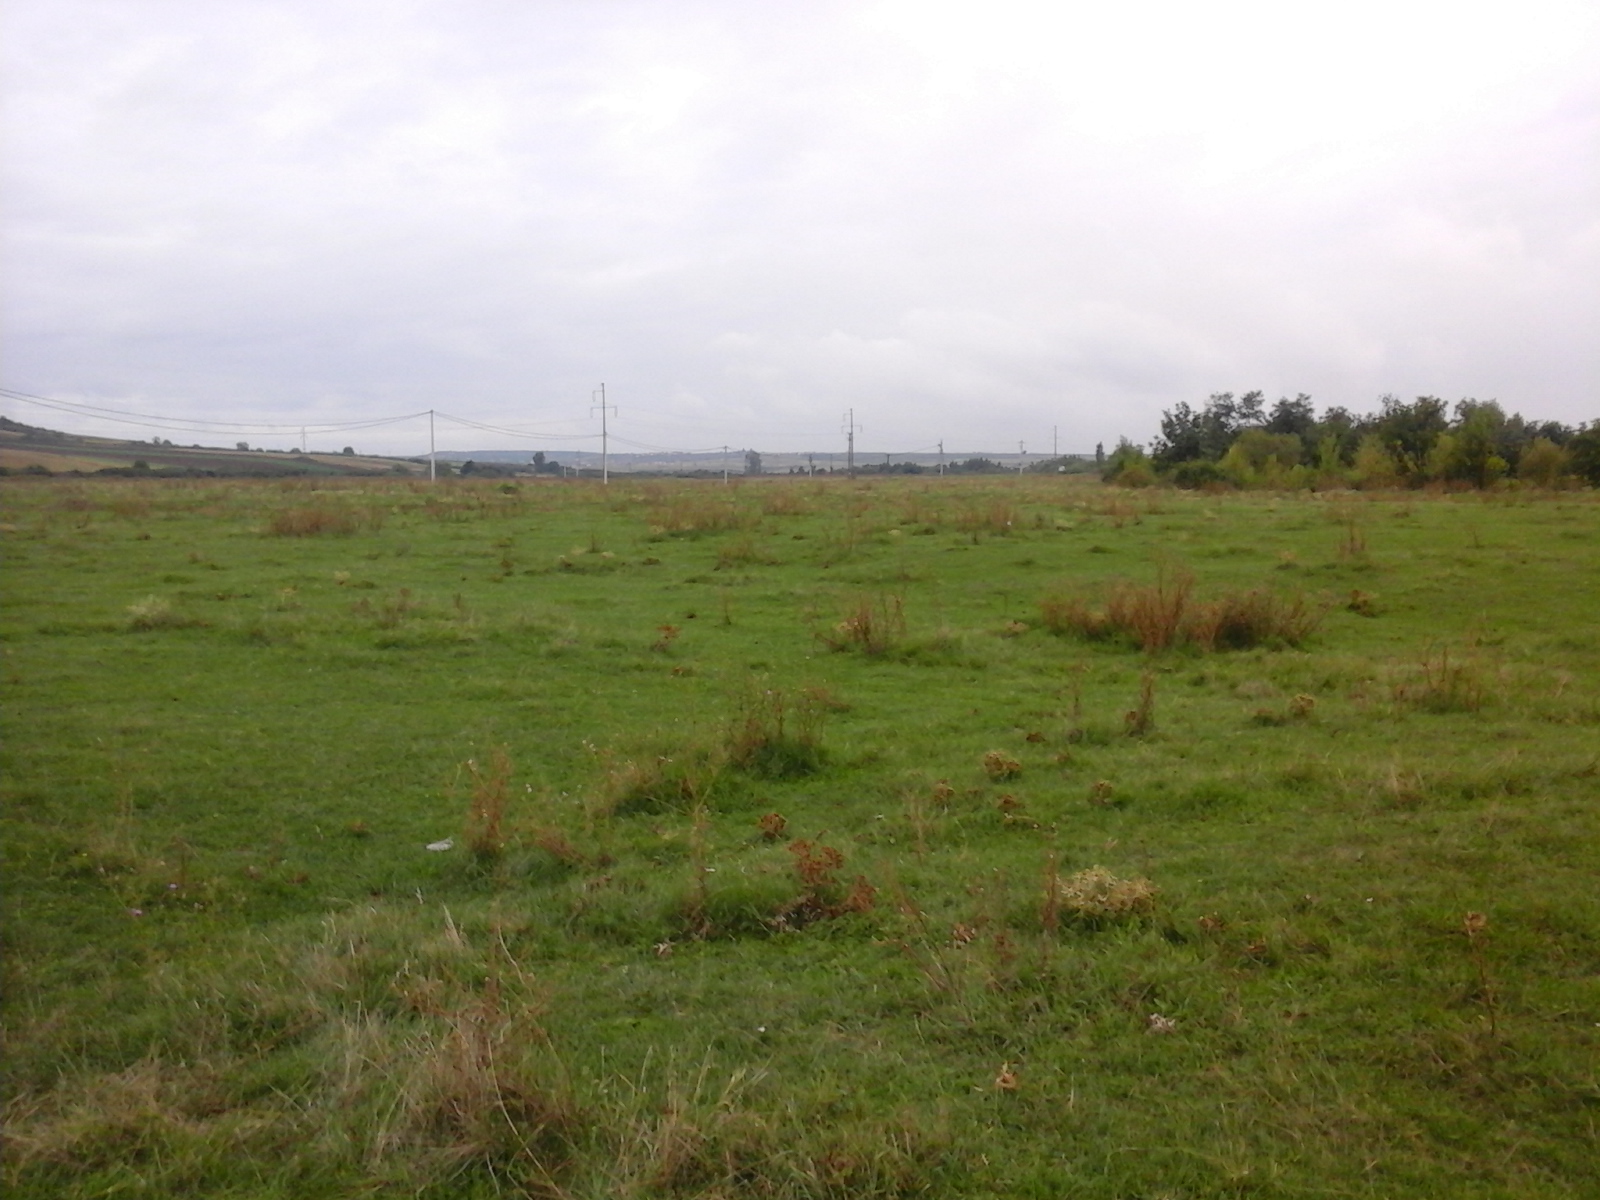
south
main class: Grassland
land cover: Spontaneously vegetated surfaces
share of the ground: > 75 %
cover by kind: herbaceous plants 100 %
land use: Agriculture (excluding fallow land and kitchen gardens)
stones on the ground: < 10 %
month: September
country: RO
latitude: 47.1547
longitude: 21.9303
